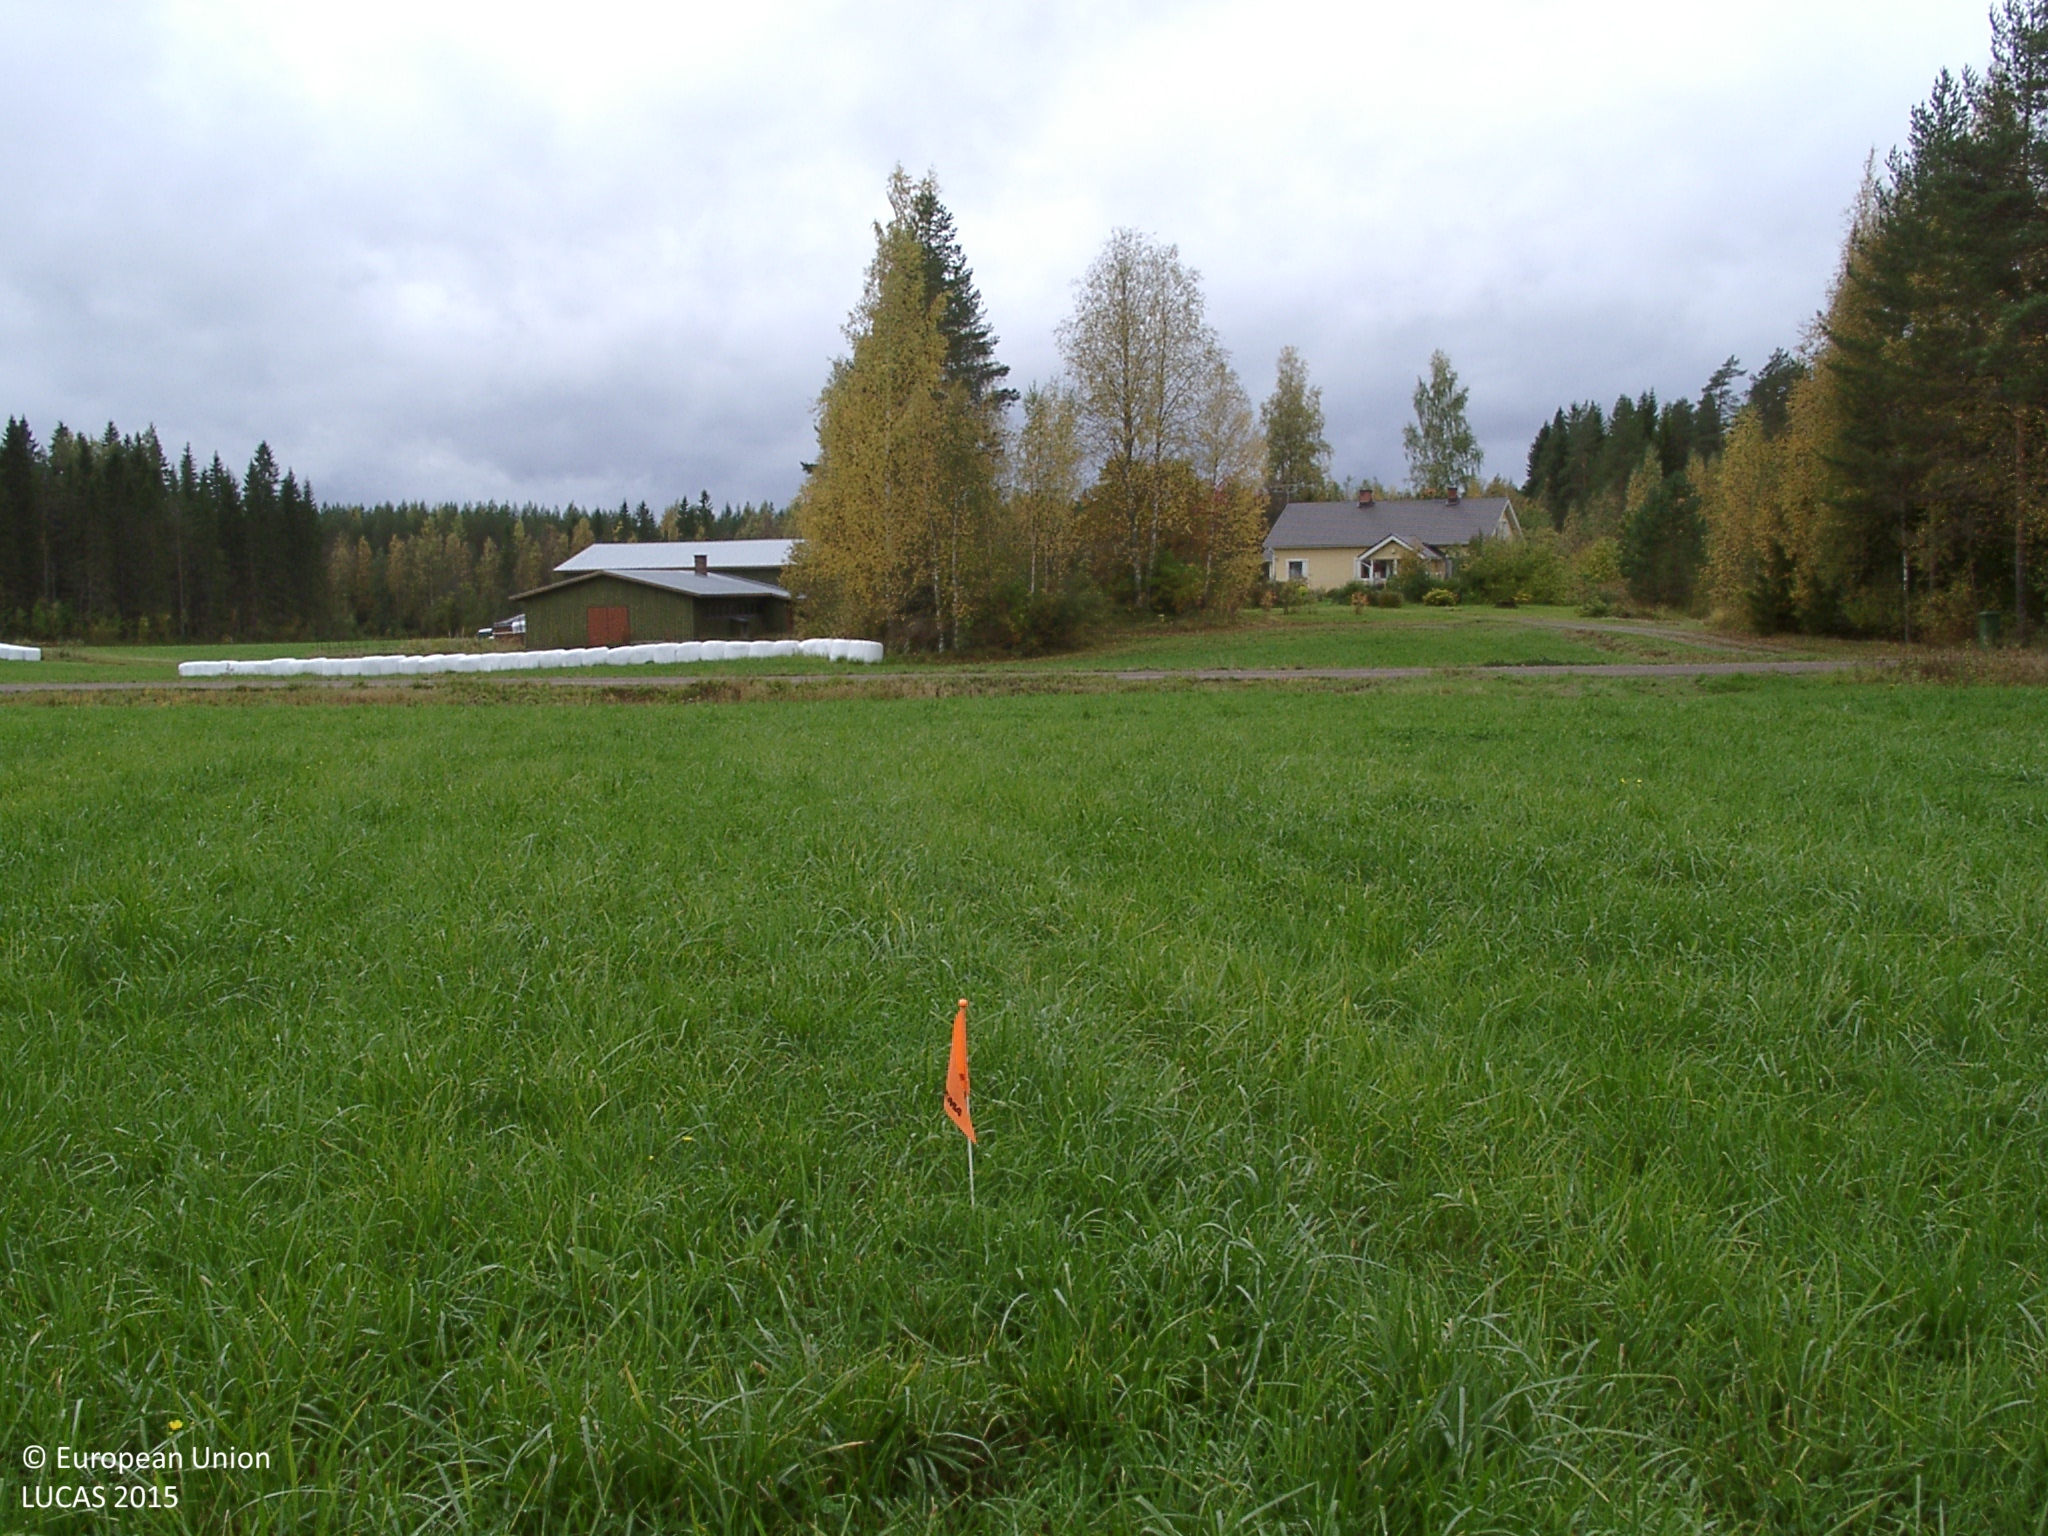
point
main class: Cropland
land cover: Other leguminous and mixtures for fodder
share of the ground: > 75 %
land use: Agriculture (excluding fallow land and kitchen gardens)
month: September
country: FI
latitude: 62.7888
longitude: 25.4163
